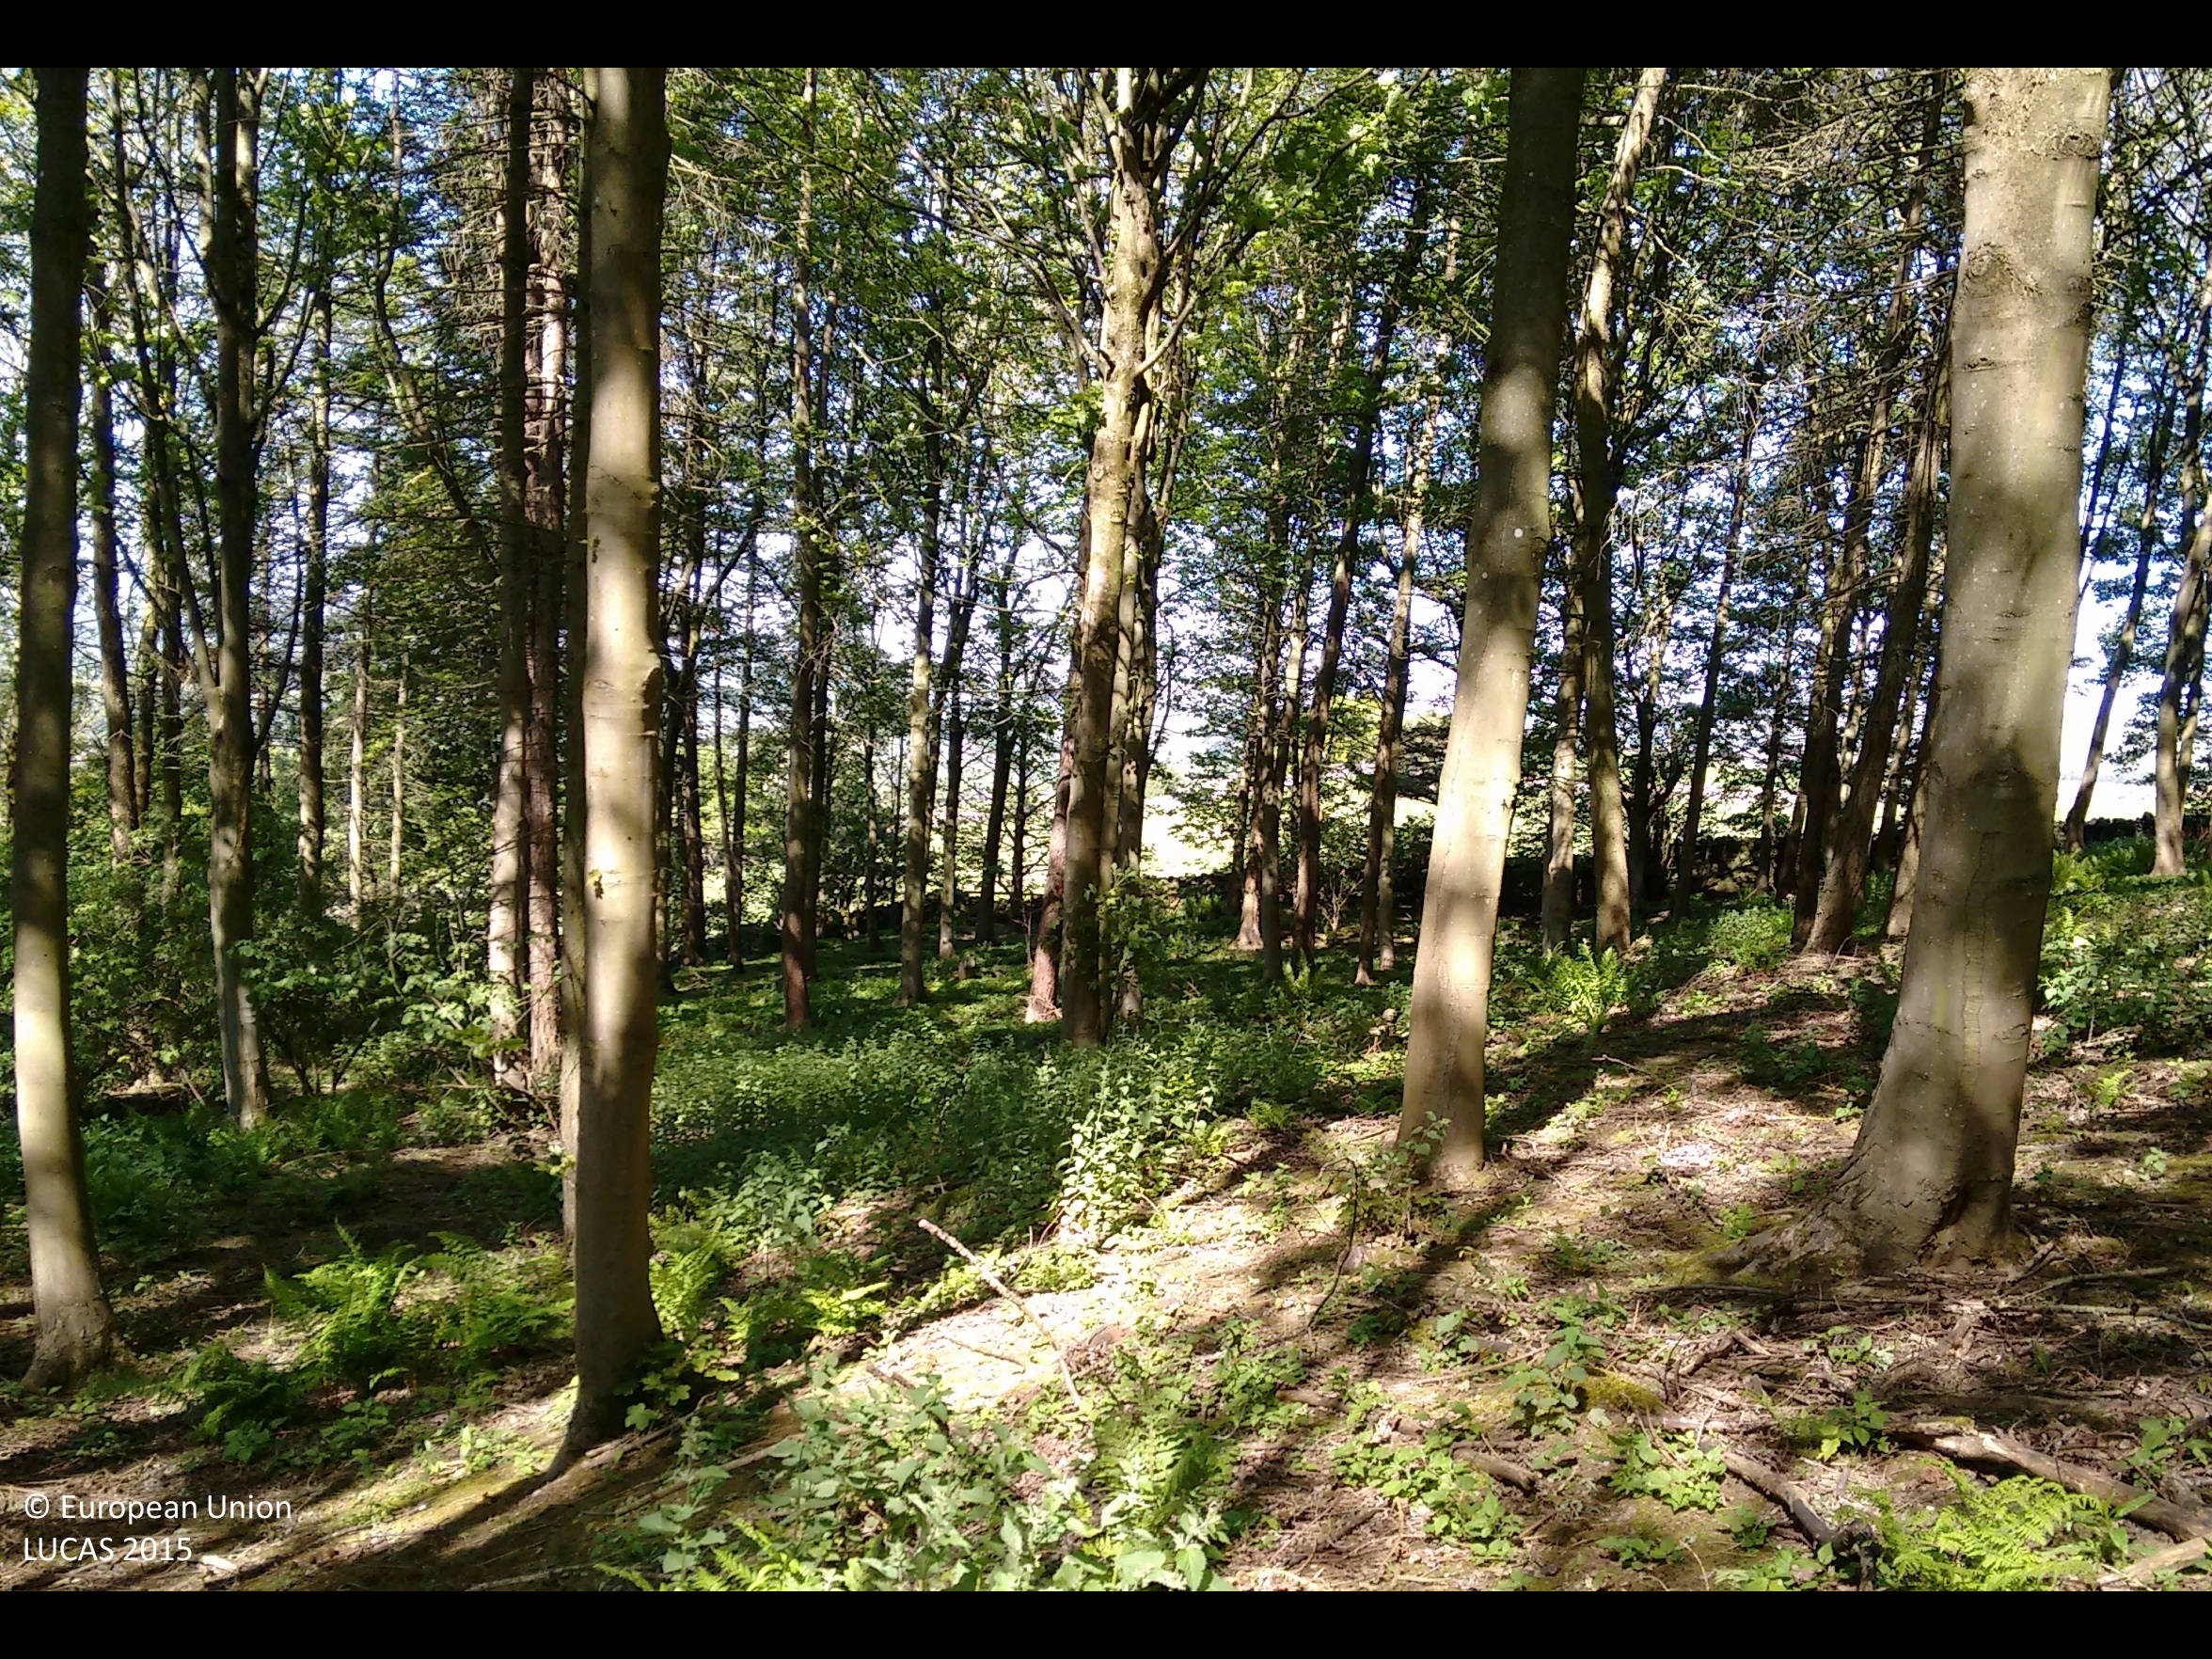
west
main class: Woodland
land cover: Broadleaved woodland
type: mesophytic deciduous forest
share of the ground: > 75 %
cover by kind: broadleaved forest trees 75 %, coniferous forest trees 25 %
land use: Forestry
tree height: > 5 m
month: June
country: GB
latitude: 54.3211
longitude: -1.9083
